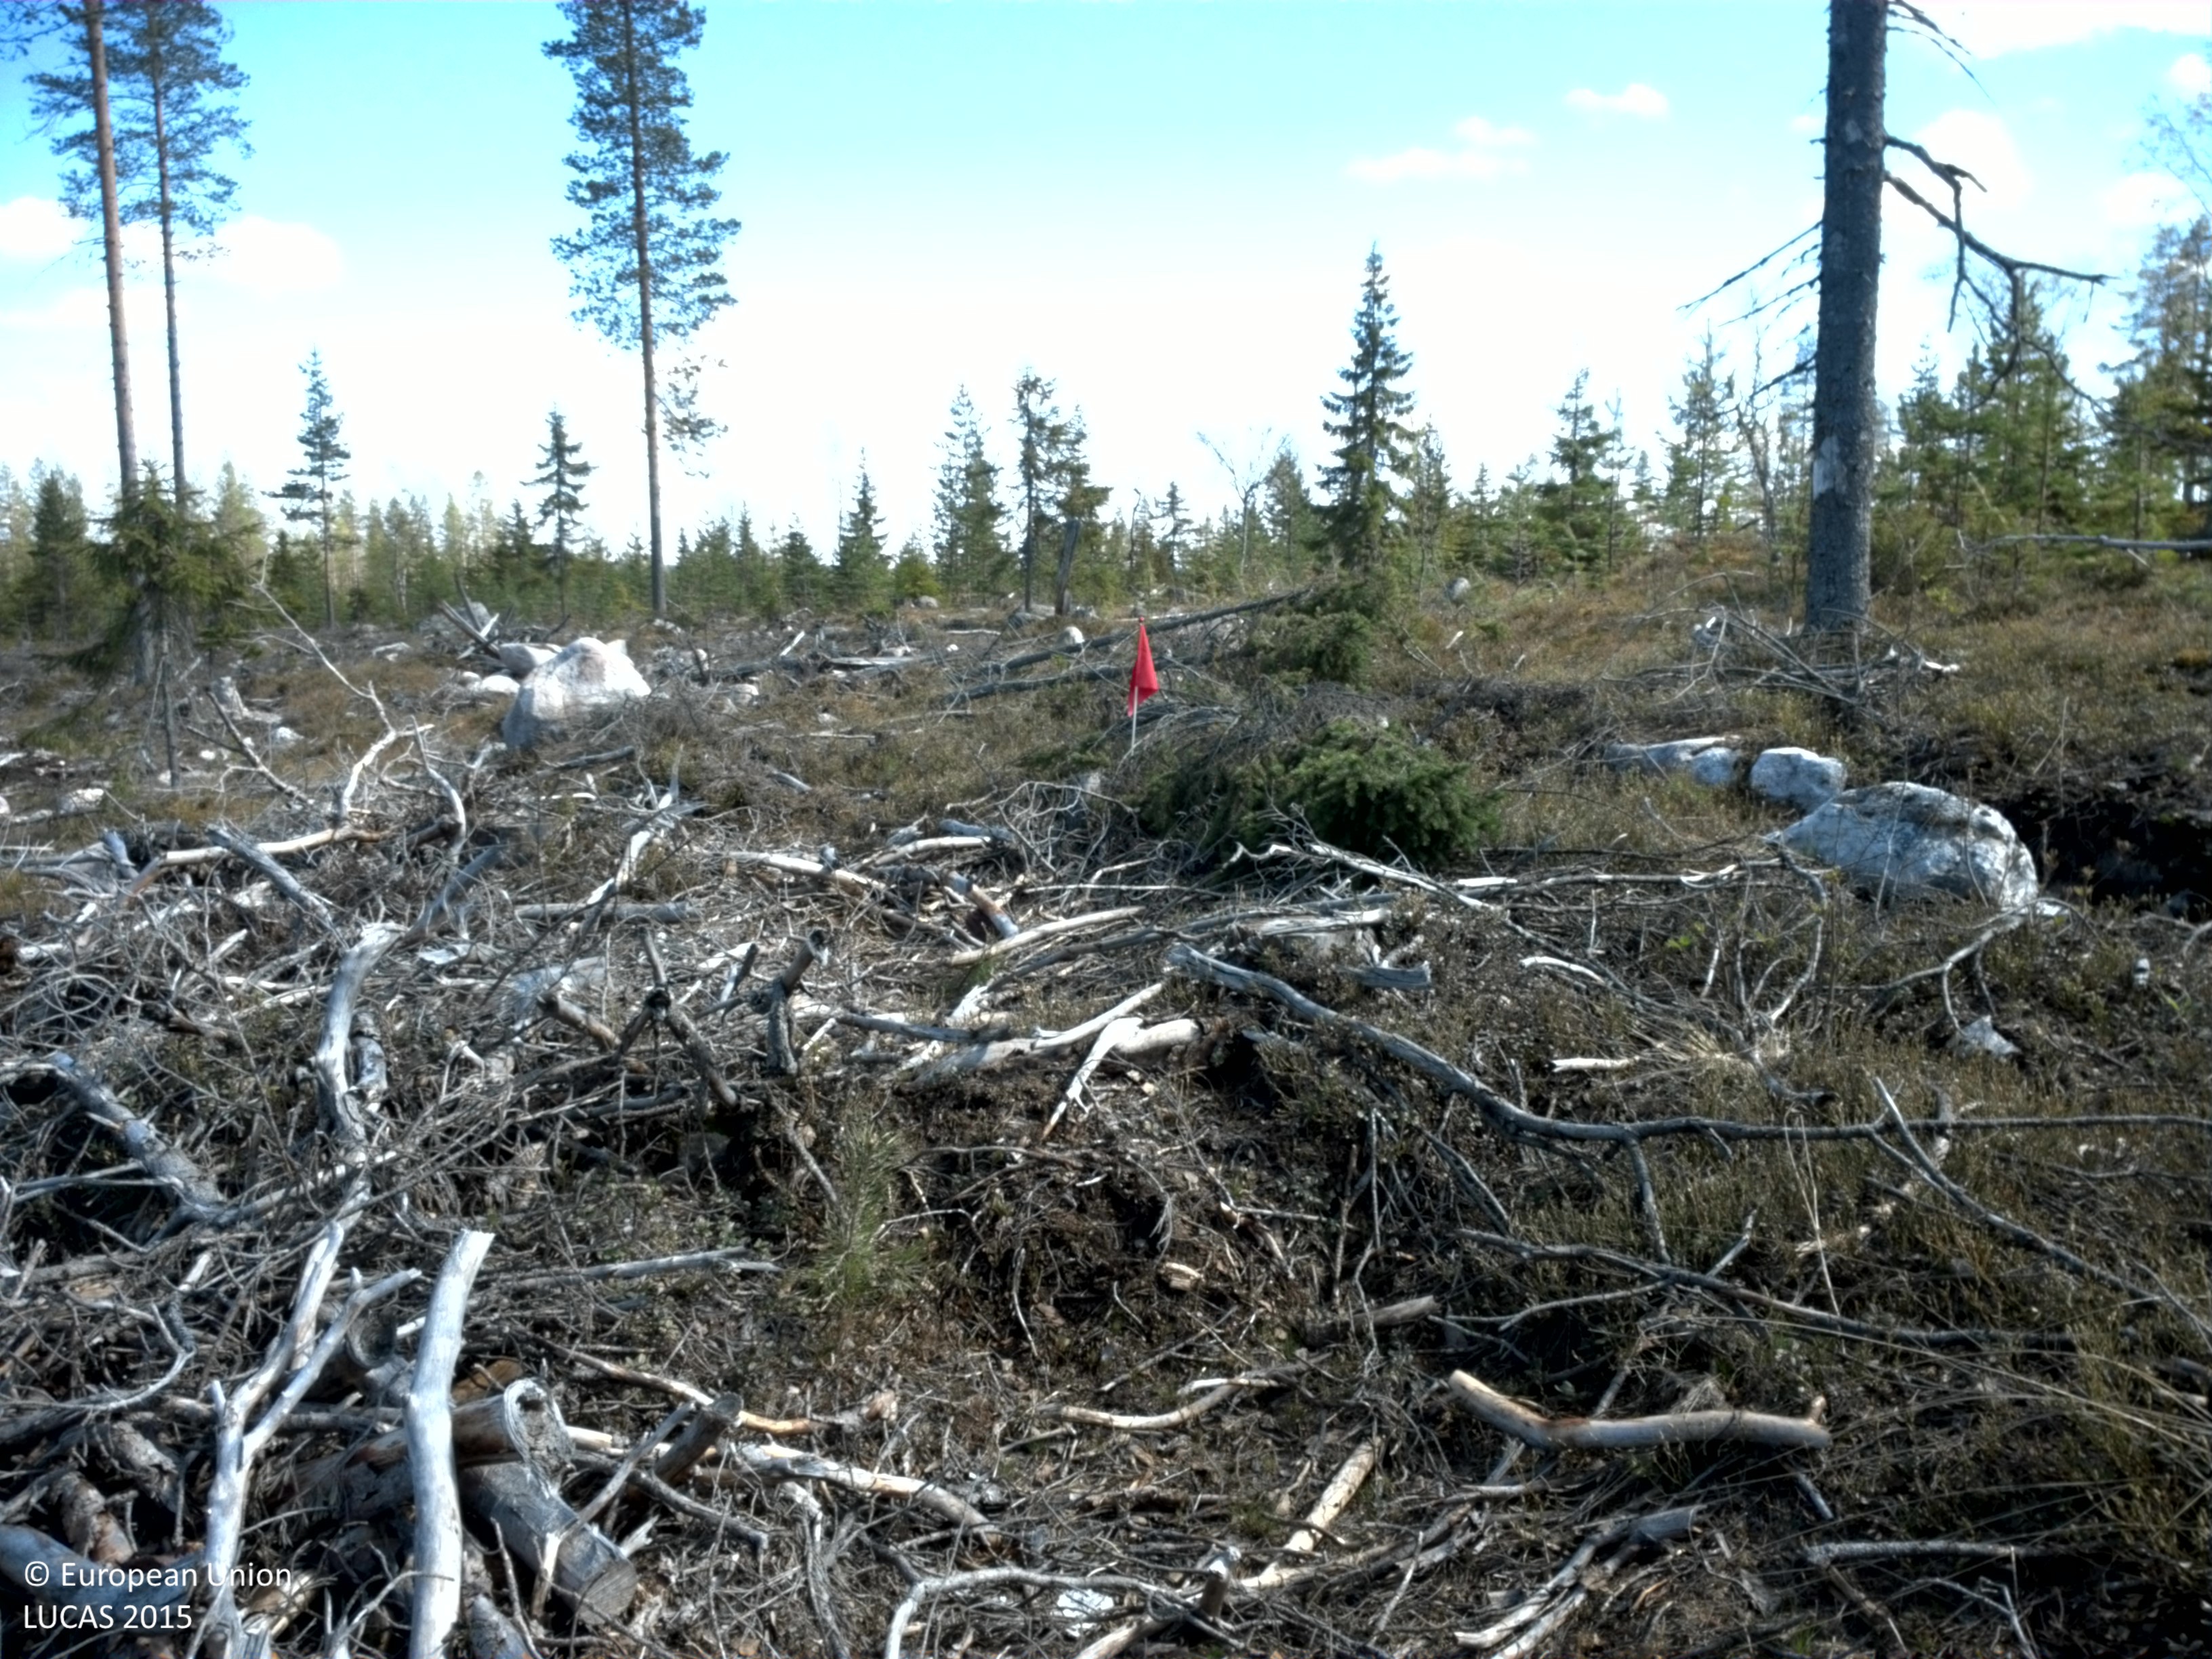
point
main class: Shrubland
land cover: Shrubland with sparse tree cover
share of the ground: > 75 %
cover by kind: shrubs 85 %, unconsolidated bare surface 10 %, coniferous forest trees 5 %
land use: Forestry
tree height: < 5 m
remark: Clear cut
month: May
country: SE
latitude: 66.1267
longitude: 23.1597
